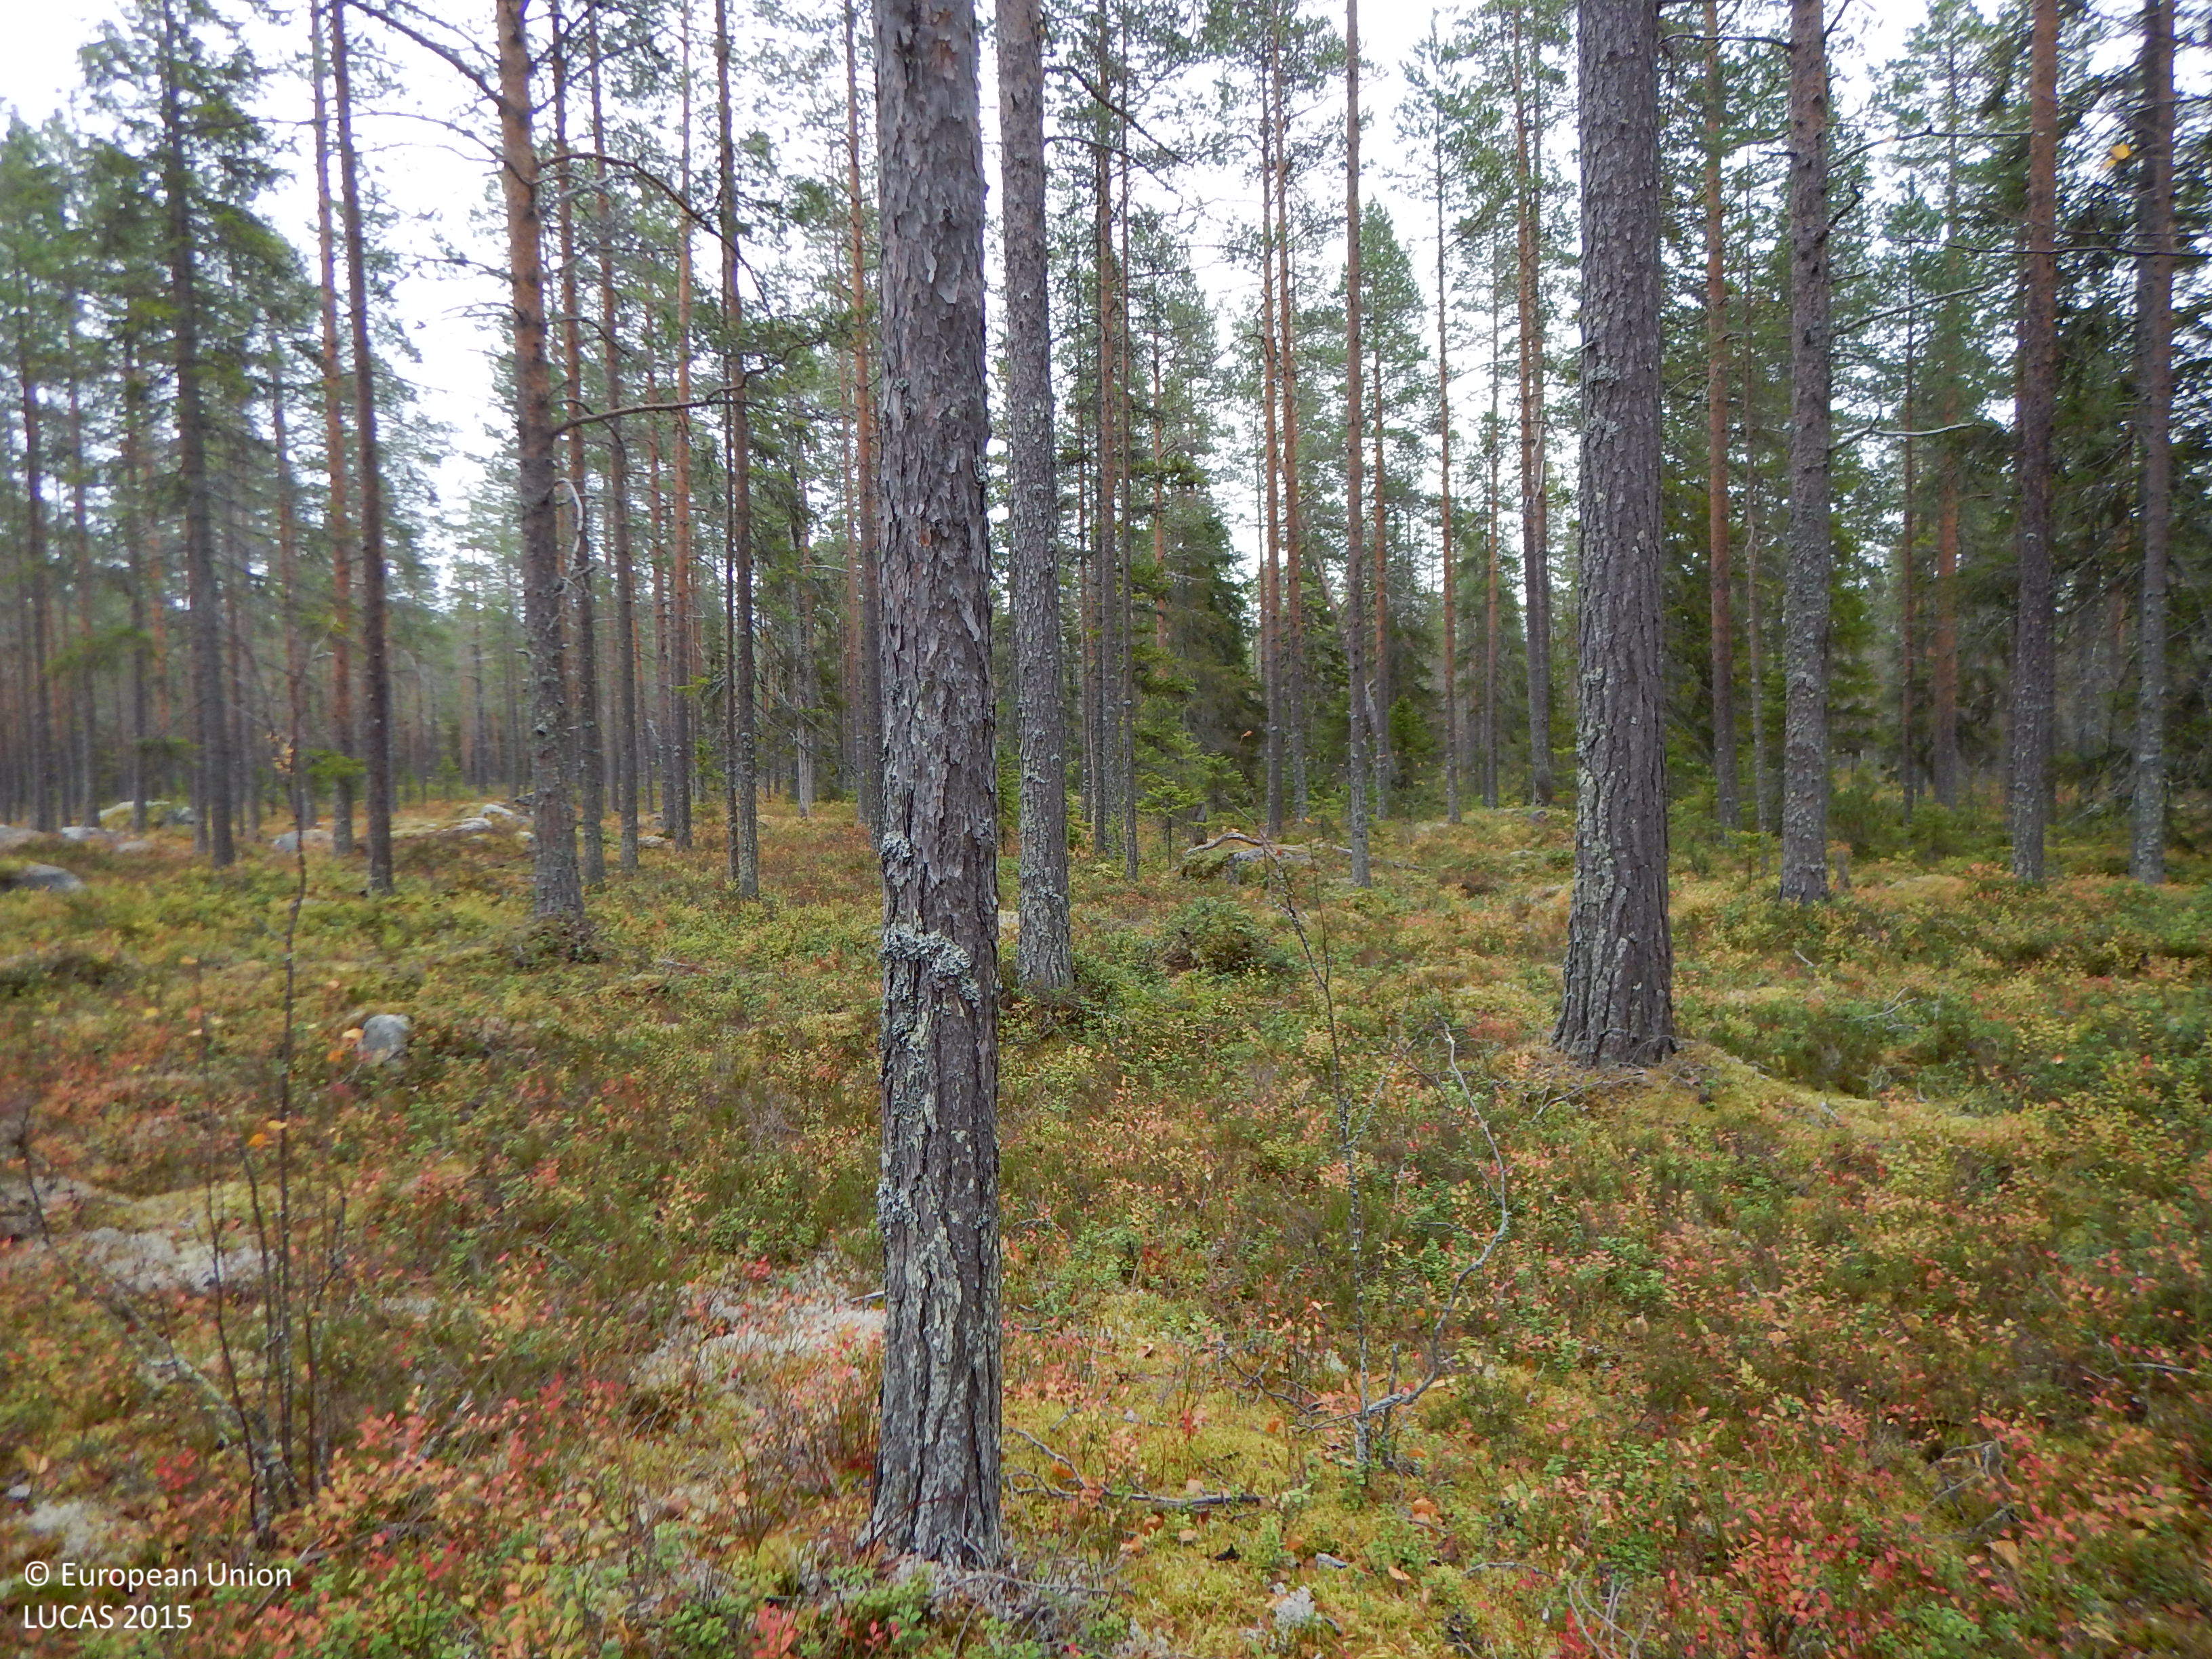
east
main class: Woodland
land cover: Pine dominated coniferous woodland
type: boreal forest
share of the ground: 50 - 75 %
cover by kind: coniferous forest trees 65 %, shrubs 15 %, lichens and mosses 15 %, herbaceous plants 5 %
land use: Forestry
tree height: > 5 m
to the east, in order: Pine dominated coniferous woodland; Other coniferous woodland; Spruce dominated coniferous woodland
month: October
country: SE
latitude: 64.9616
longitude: 21.0517
